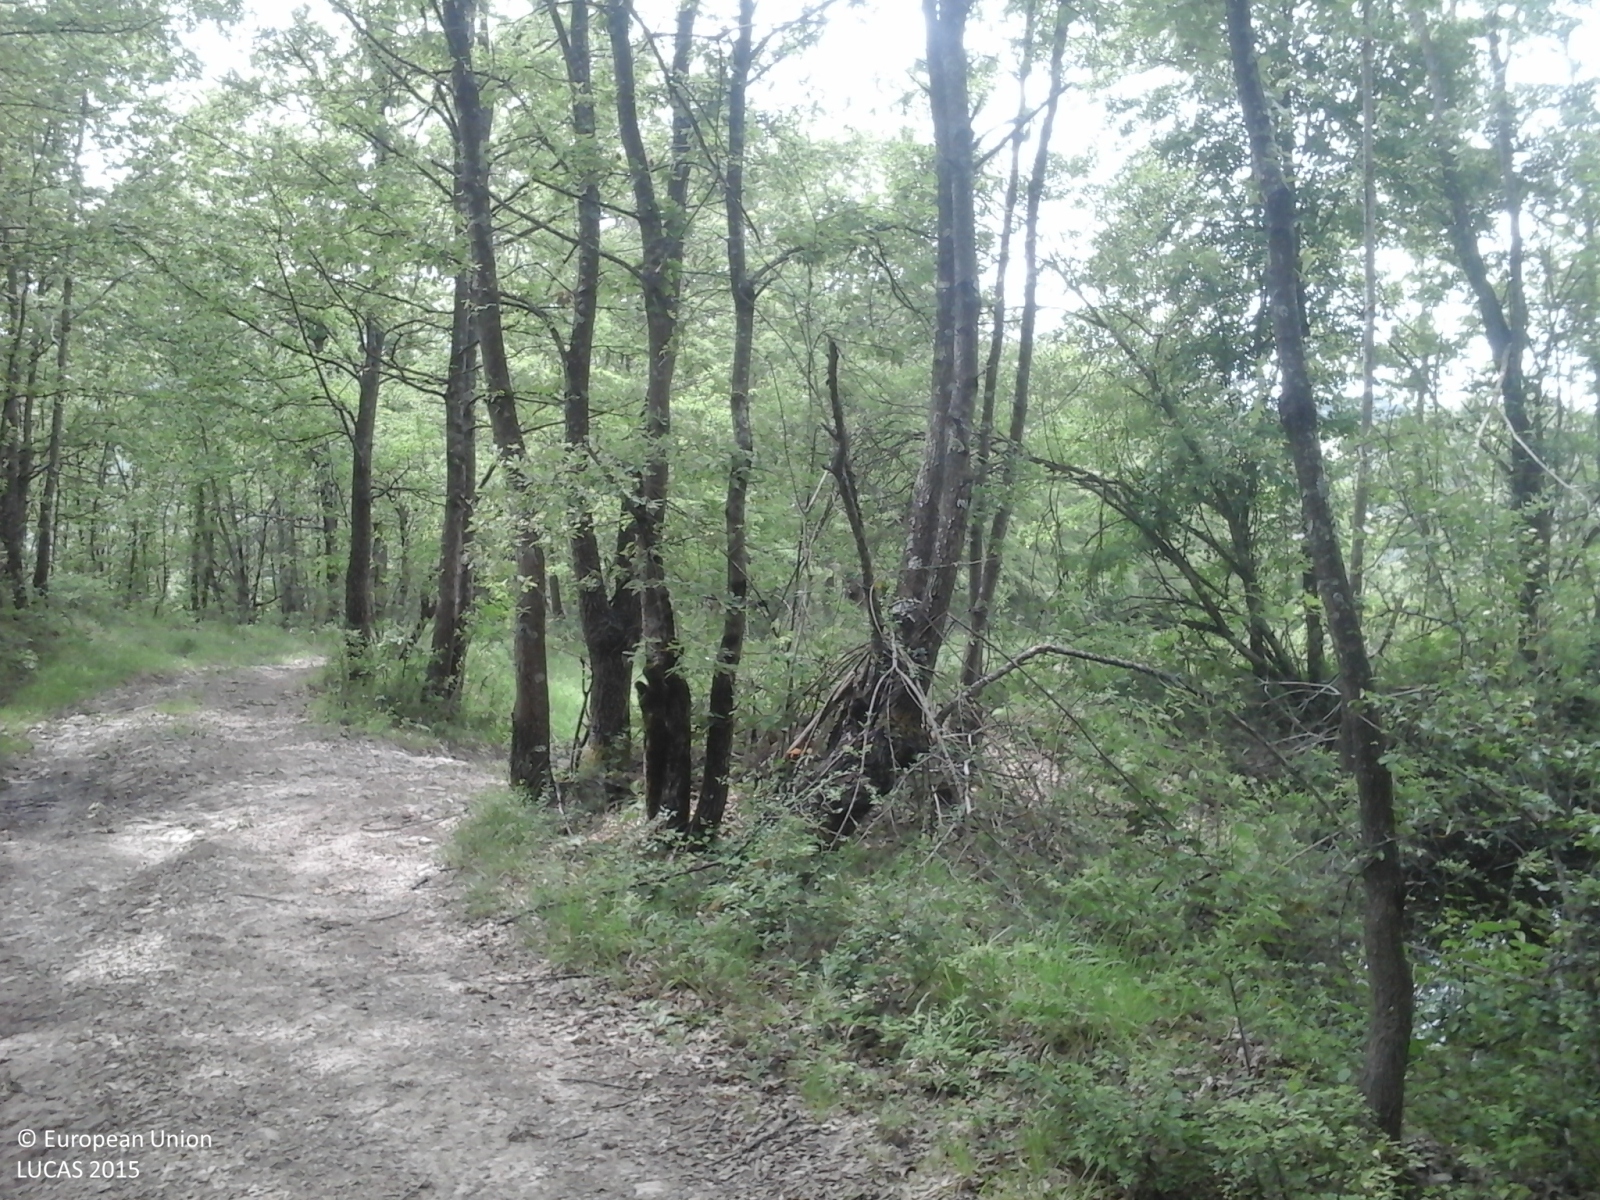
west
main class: Woodland
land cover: Broadleaved woodland
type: thermophilous deciduous forest
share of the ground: > 75 %
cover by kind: broadleaved forest trees 90 %, shrubs 5 %, herbaceous plants 5 %
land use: Forestry
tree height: > 5 m
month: May
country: IT
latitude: 44.2388
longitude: 10.8619
